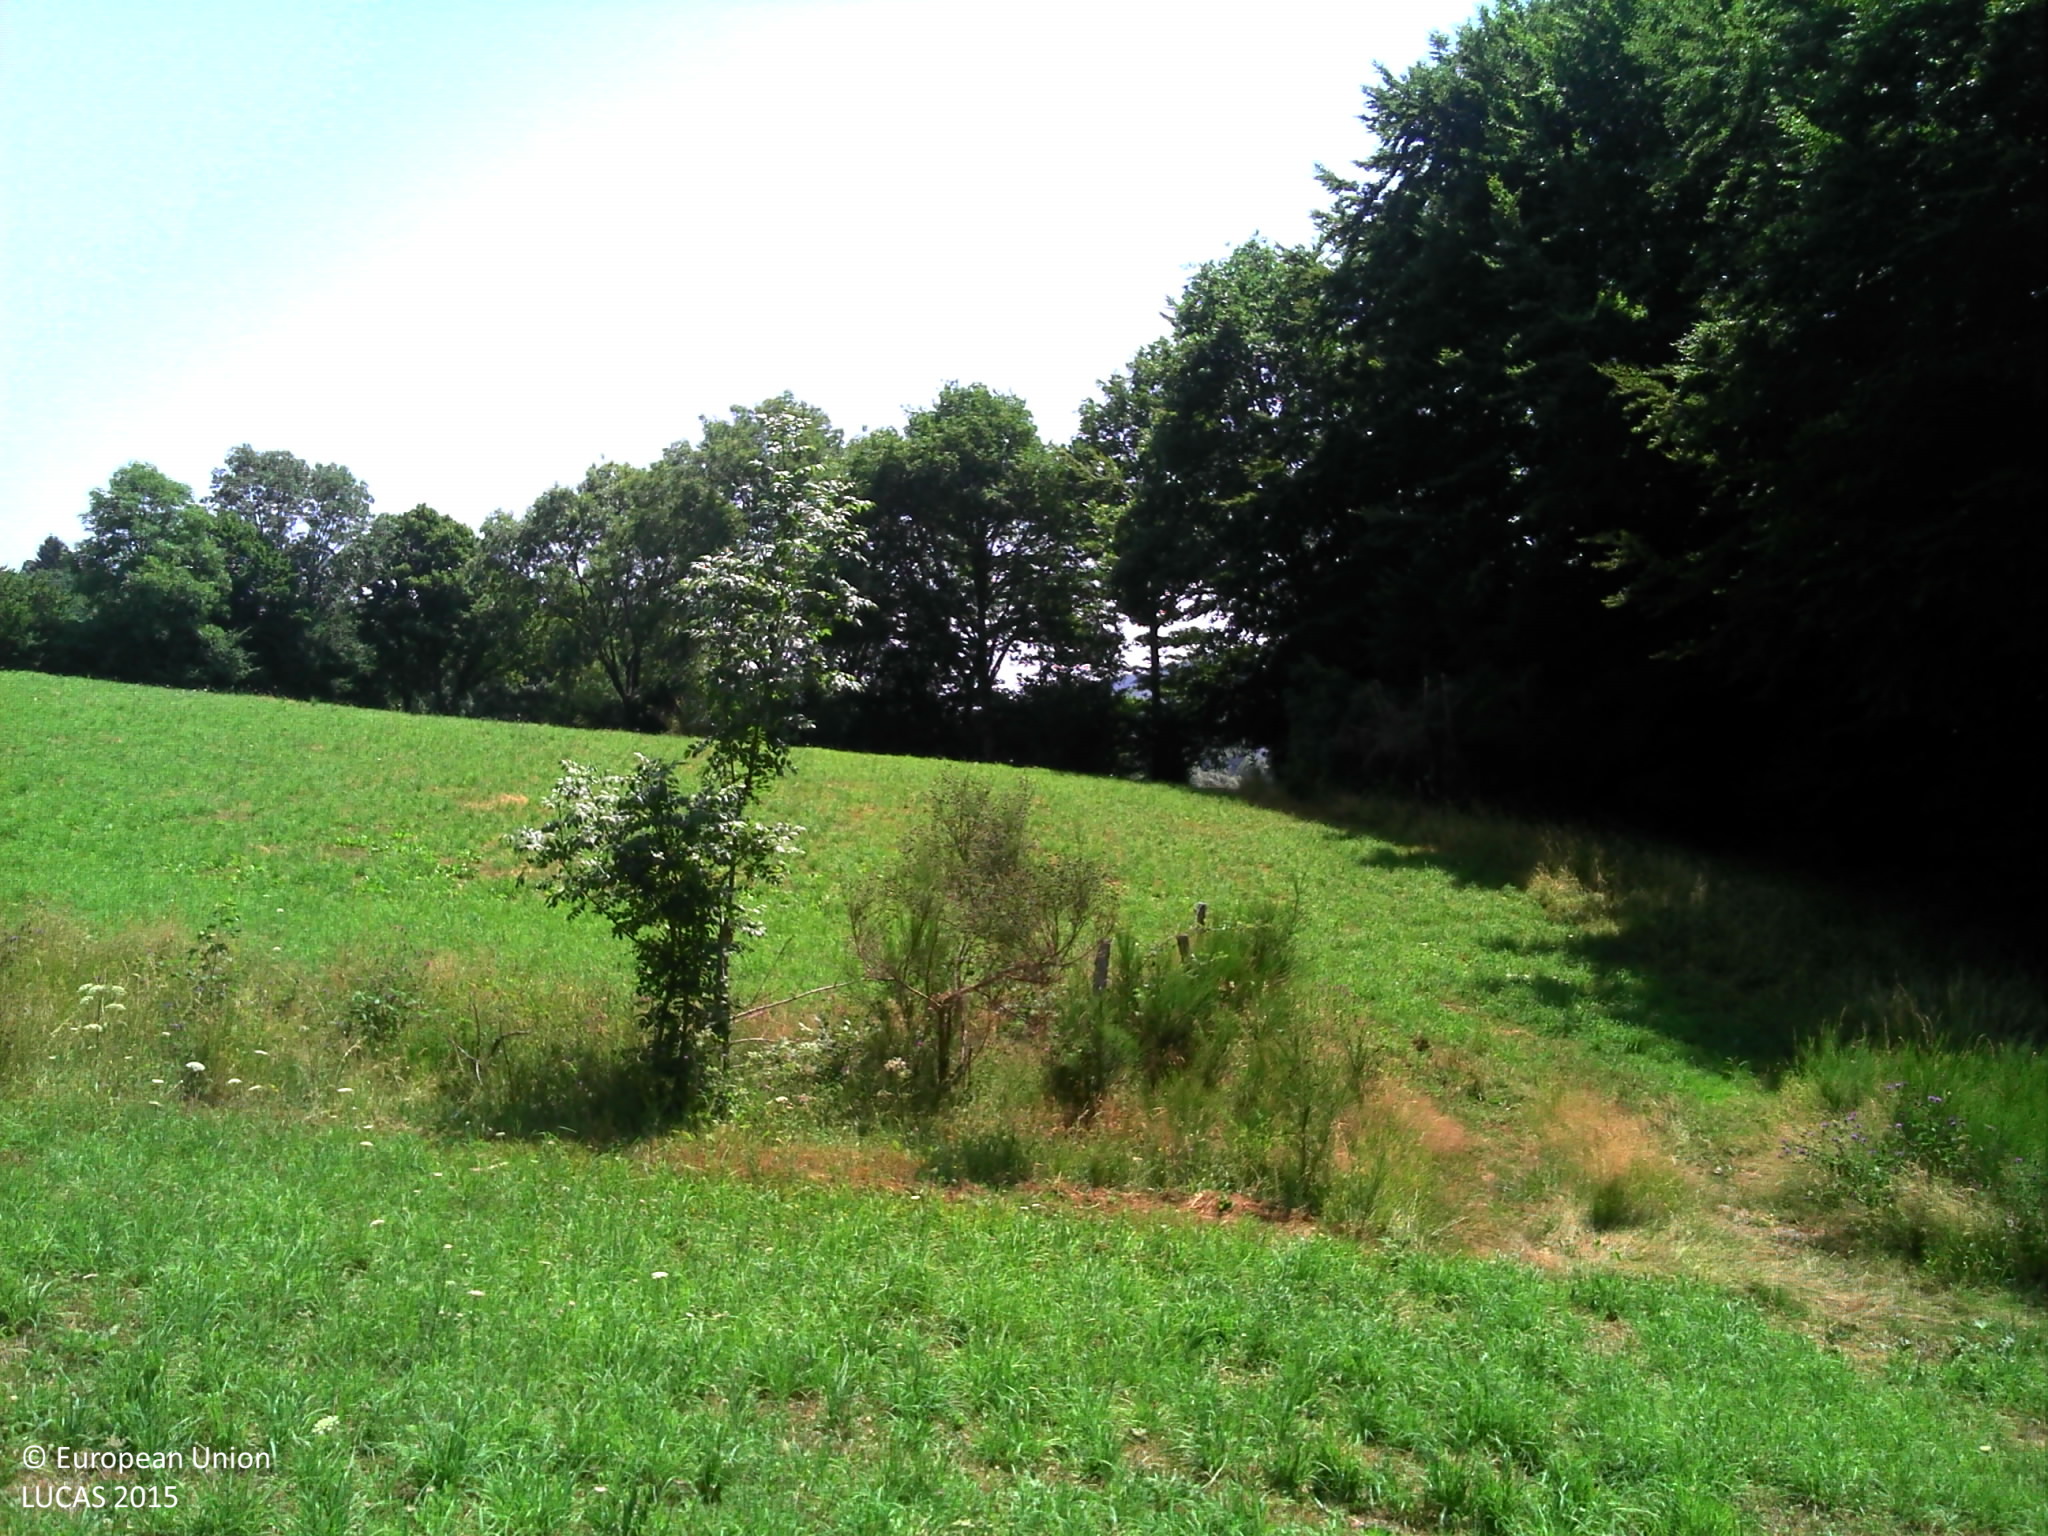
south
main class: Grassland
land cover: Grassland without tree/shrub cover
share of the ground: > 75 %
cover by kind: herbaceous plants 100 %
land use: Agriculture (excluding fallow land and kitchen gardens)
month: July
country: FR
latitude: 43.6554
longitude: 2.6539
